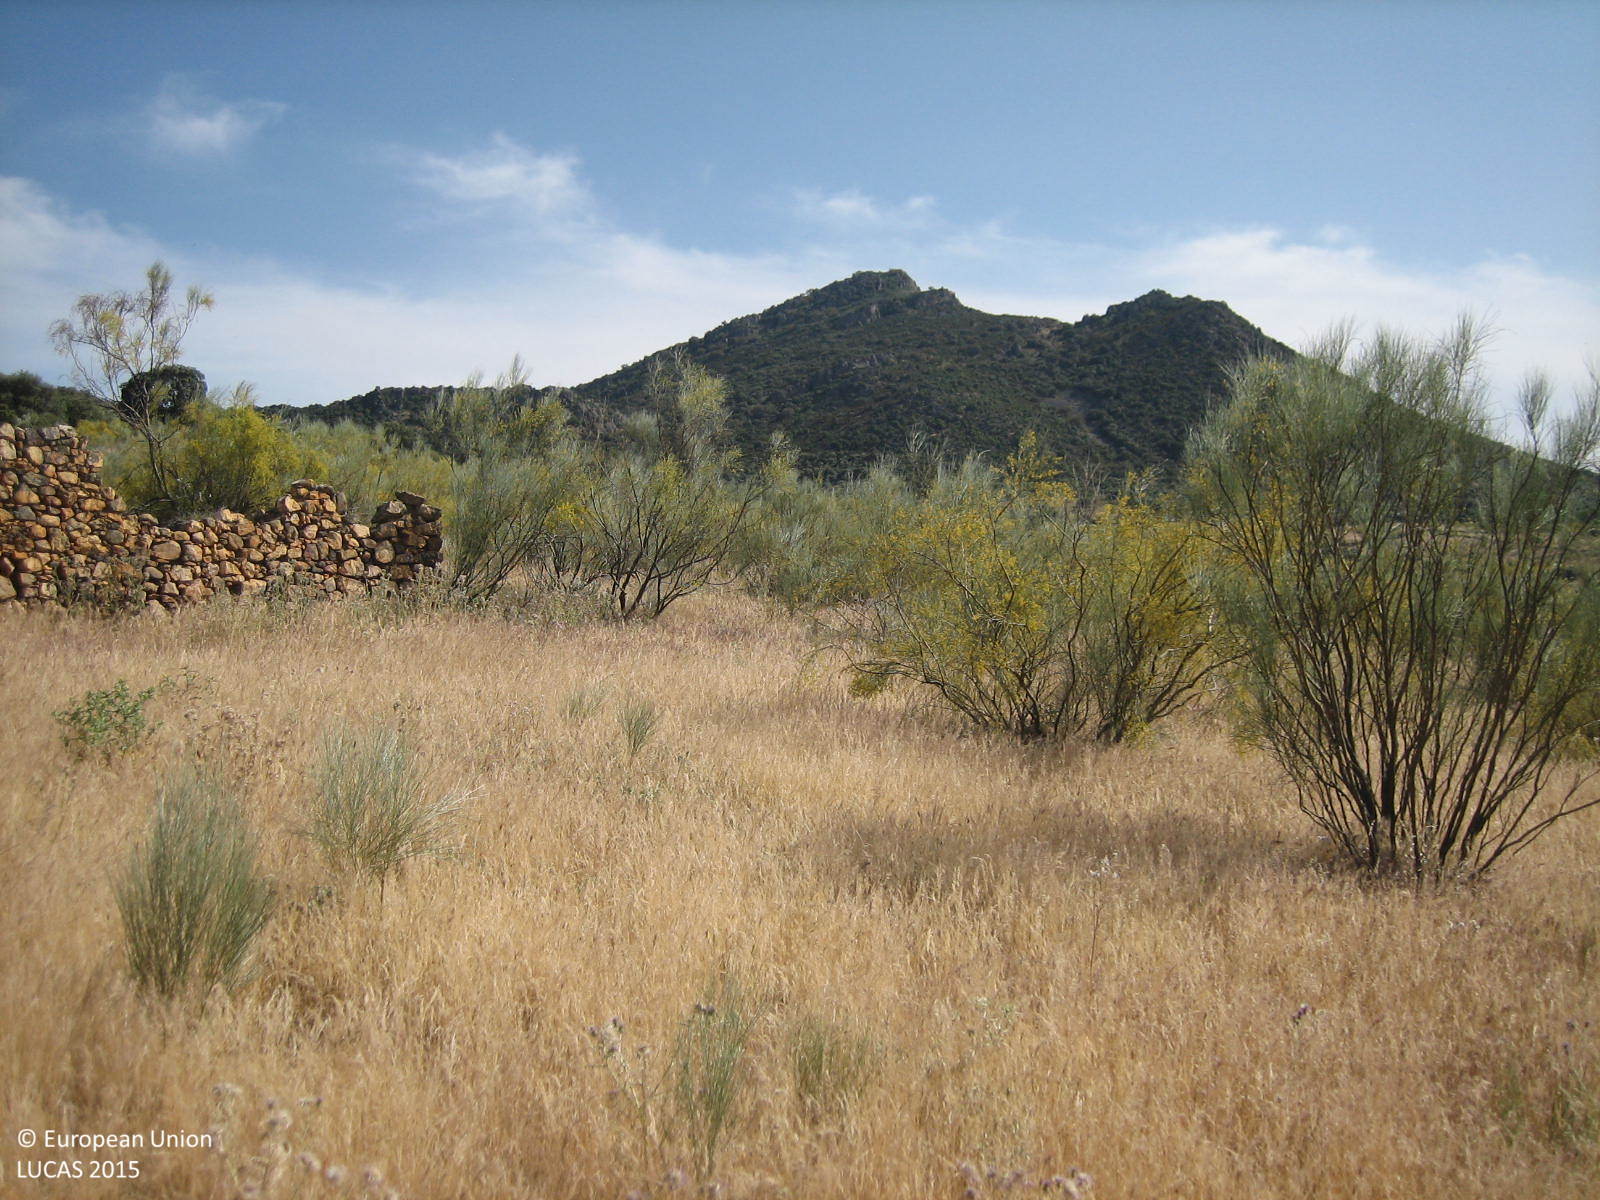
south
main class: Shrubland
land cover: Shrubland without tree cover
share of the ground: 50 - 75 %
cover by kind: shrubs 60 %, herbaceous plants 40 %
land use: Semi-natural and natural areas not in use
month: May
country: ES
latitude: 38.8281
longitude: -5.1362
